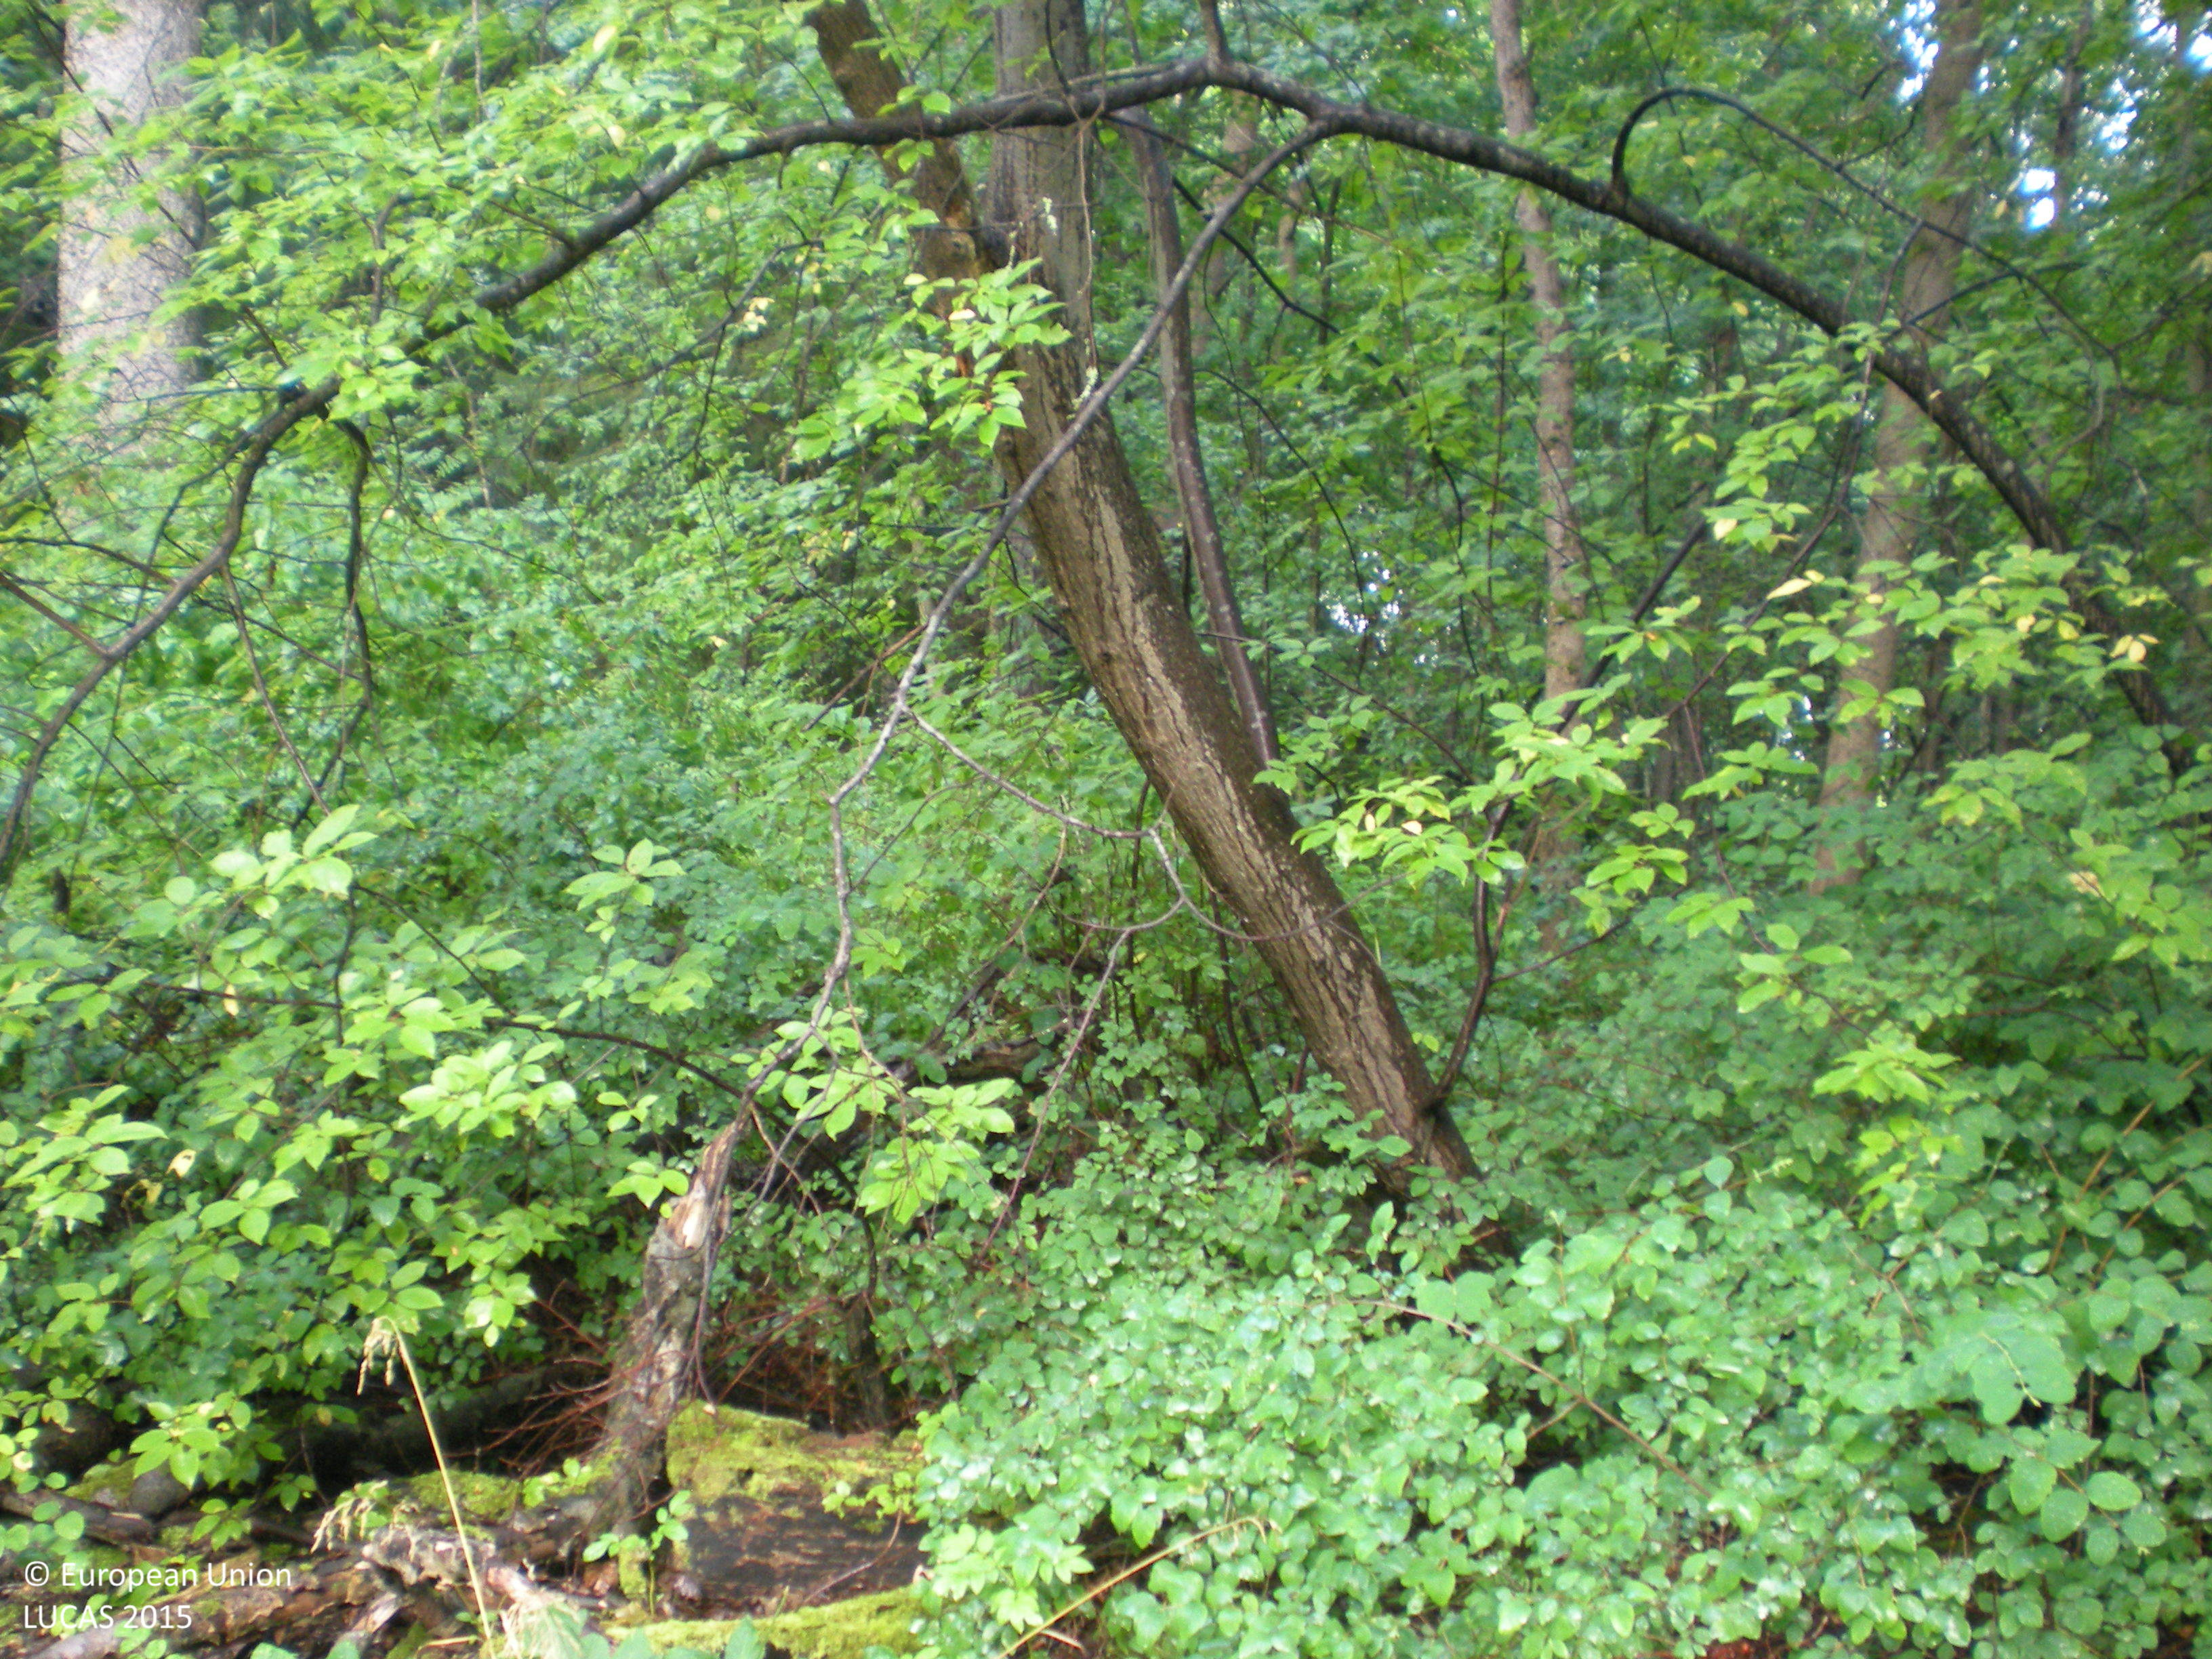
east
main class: Woodland
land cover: Broadleaved woodland
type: boreal forest
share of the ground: > 75 %
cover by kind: broadleaved forest trees 50 %, herbaceous plants 30 %, coniferous forest trees 10 %, lichens and mosses 5 %, unconsolidated bare surface 5 %
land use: Forestry
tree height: > 5 m
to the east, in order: Broadleaved woodland; Grassland with sparse tree/shrub cover; Artificial constructions in urban areas; Grassland with sparse tree/shrub cover; Broadleaved woodland; Grassland with sparse tree/shrub cover
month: August
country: SE
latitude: 60.7009
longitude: 17.2251
